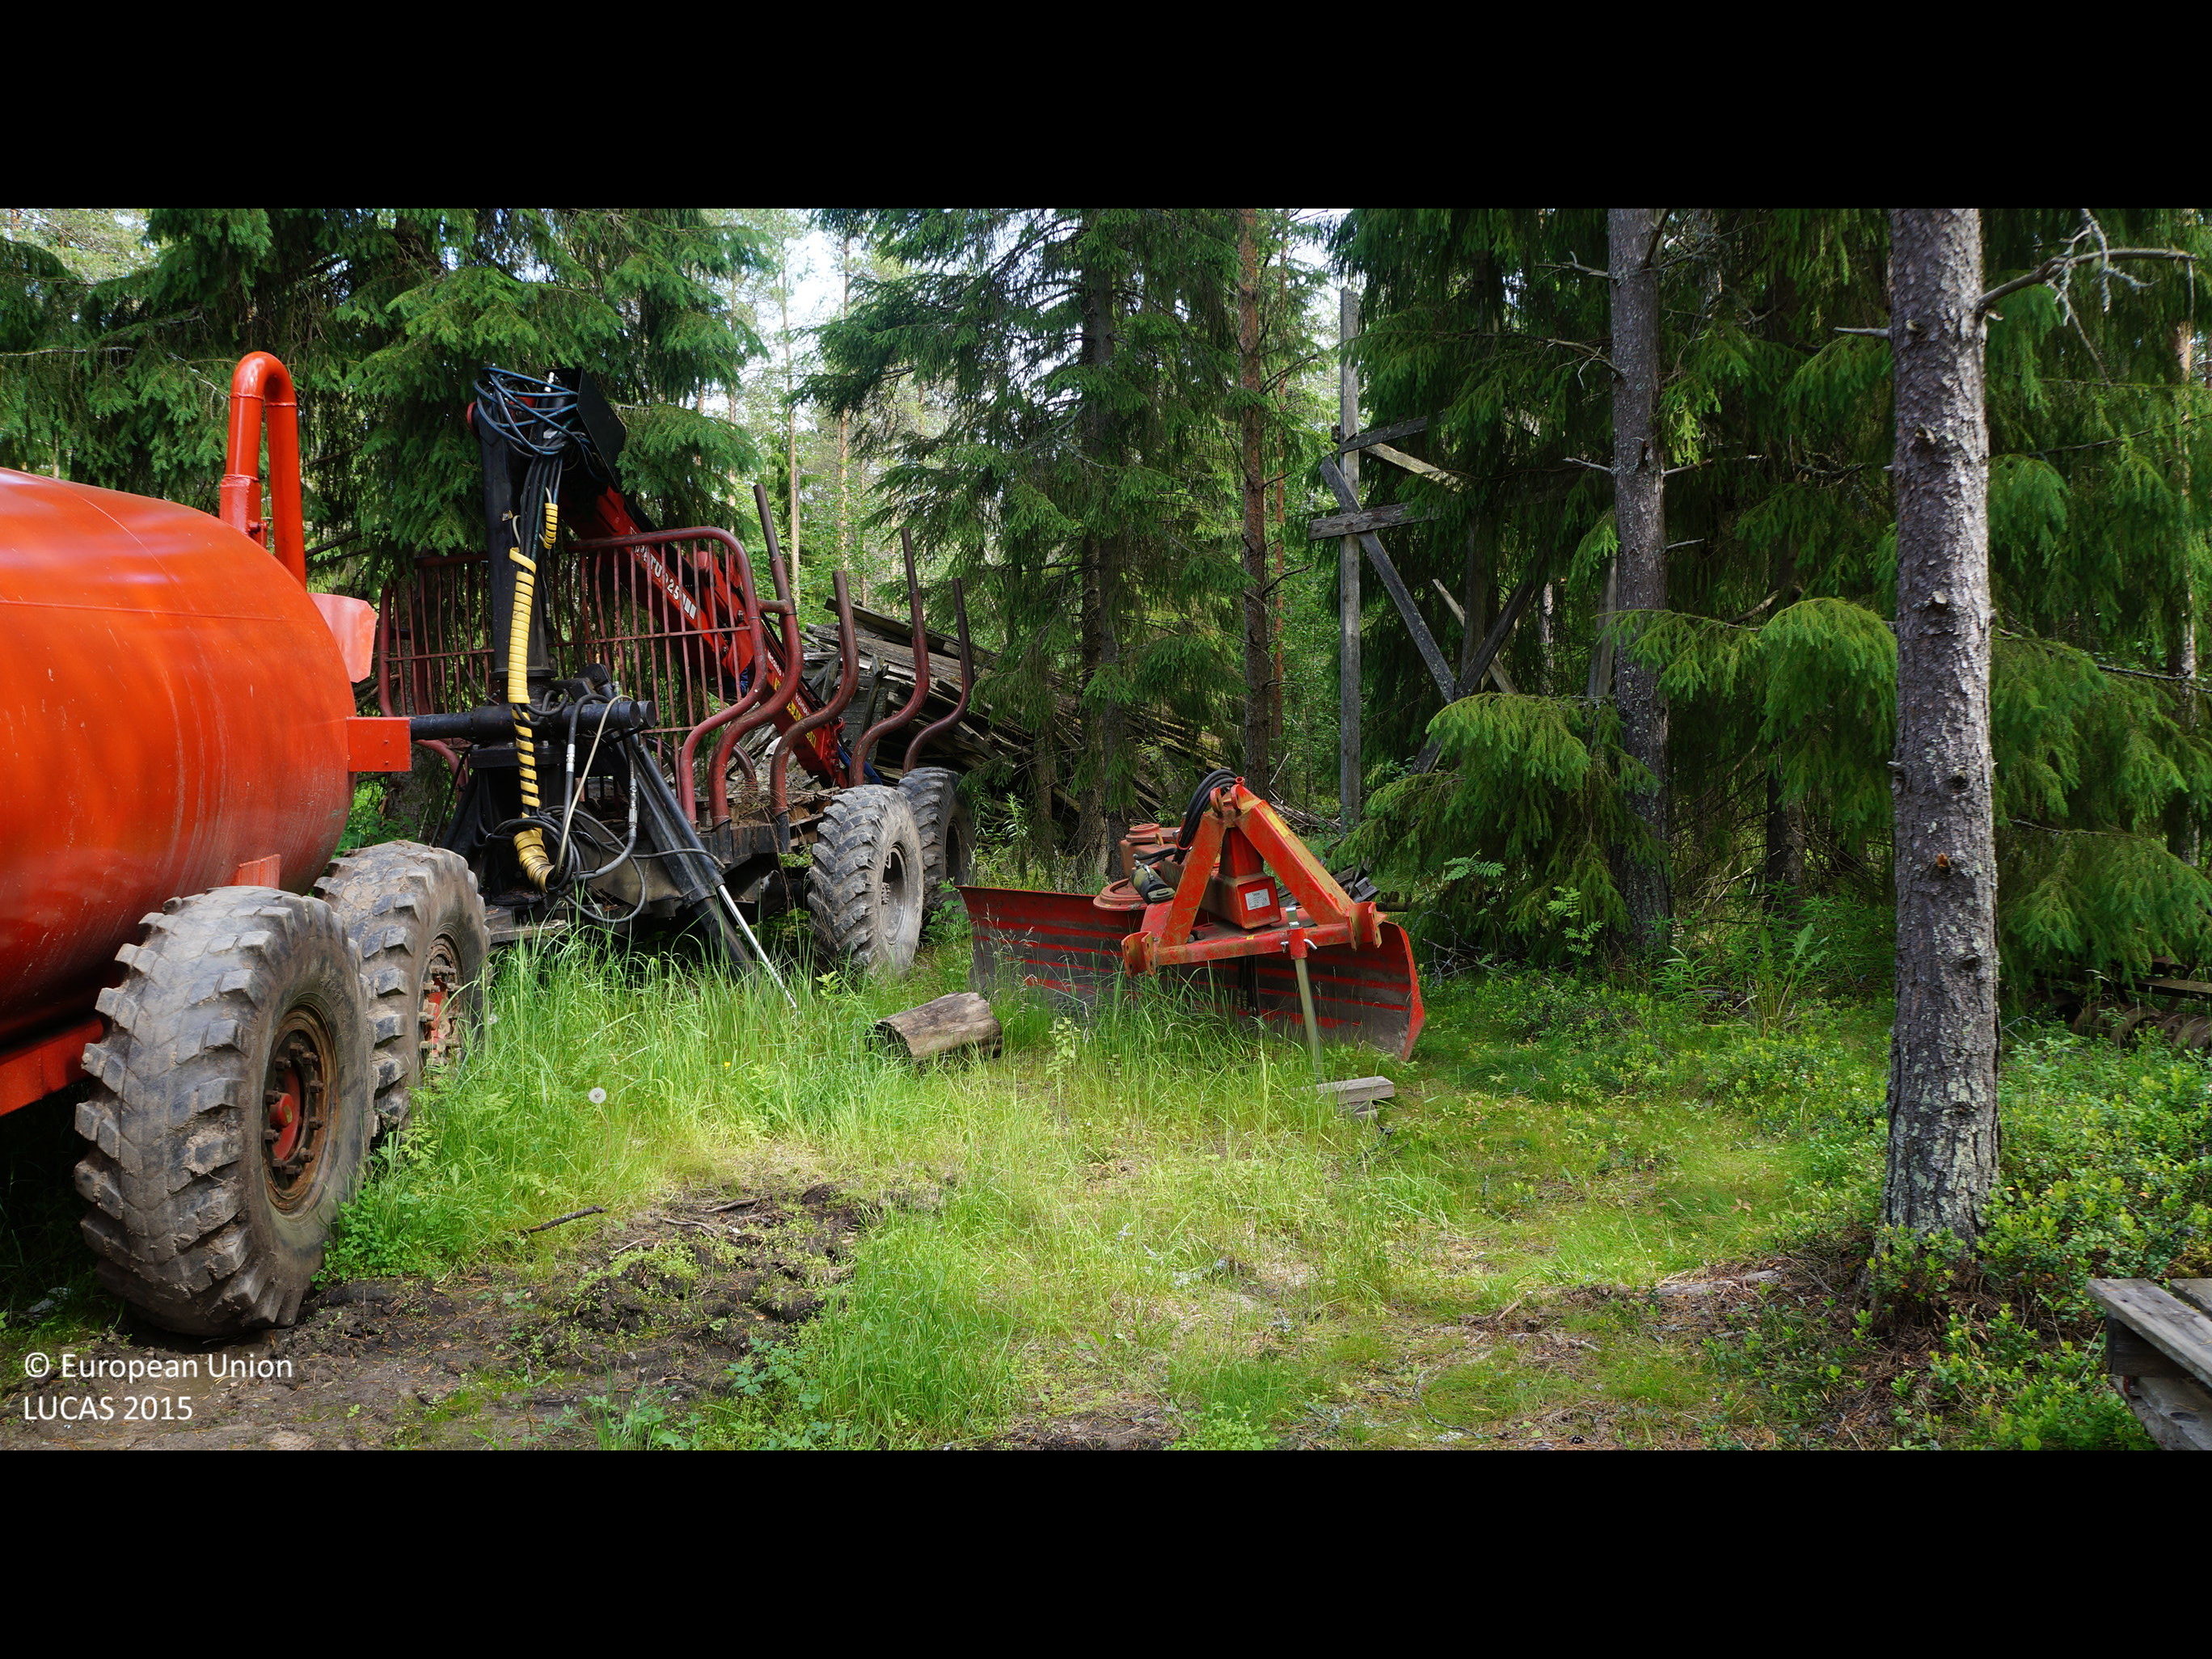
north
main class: Woodland
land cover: Pine dominated coniferous woodland
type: boreal forest
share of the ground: 50 - 75 %
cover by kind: coniferous forest trees 60 %, shrubs 30 %, herbaceous plants 5 %, lichens and mosses 5 %
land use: Forestry
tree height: > 5 m
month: July
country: FI
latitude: 64.3435
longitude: 24.4145
